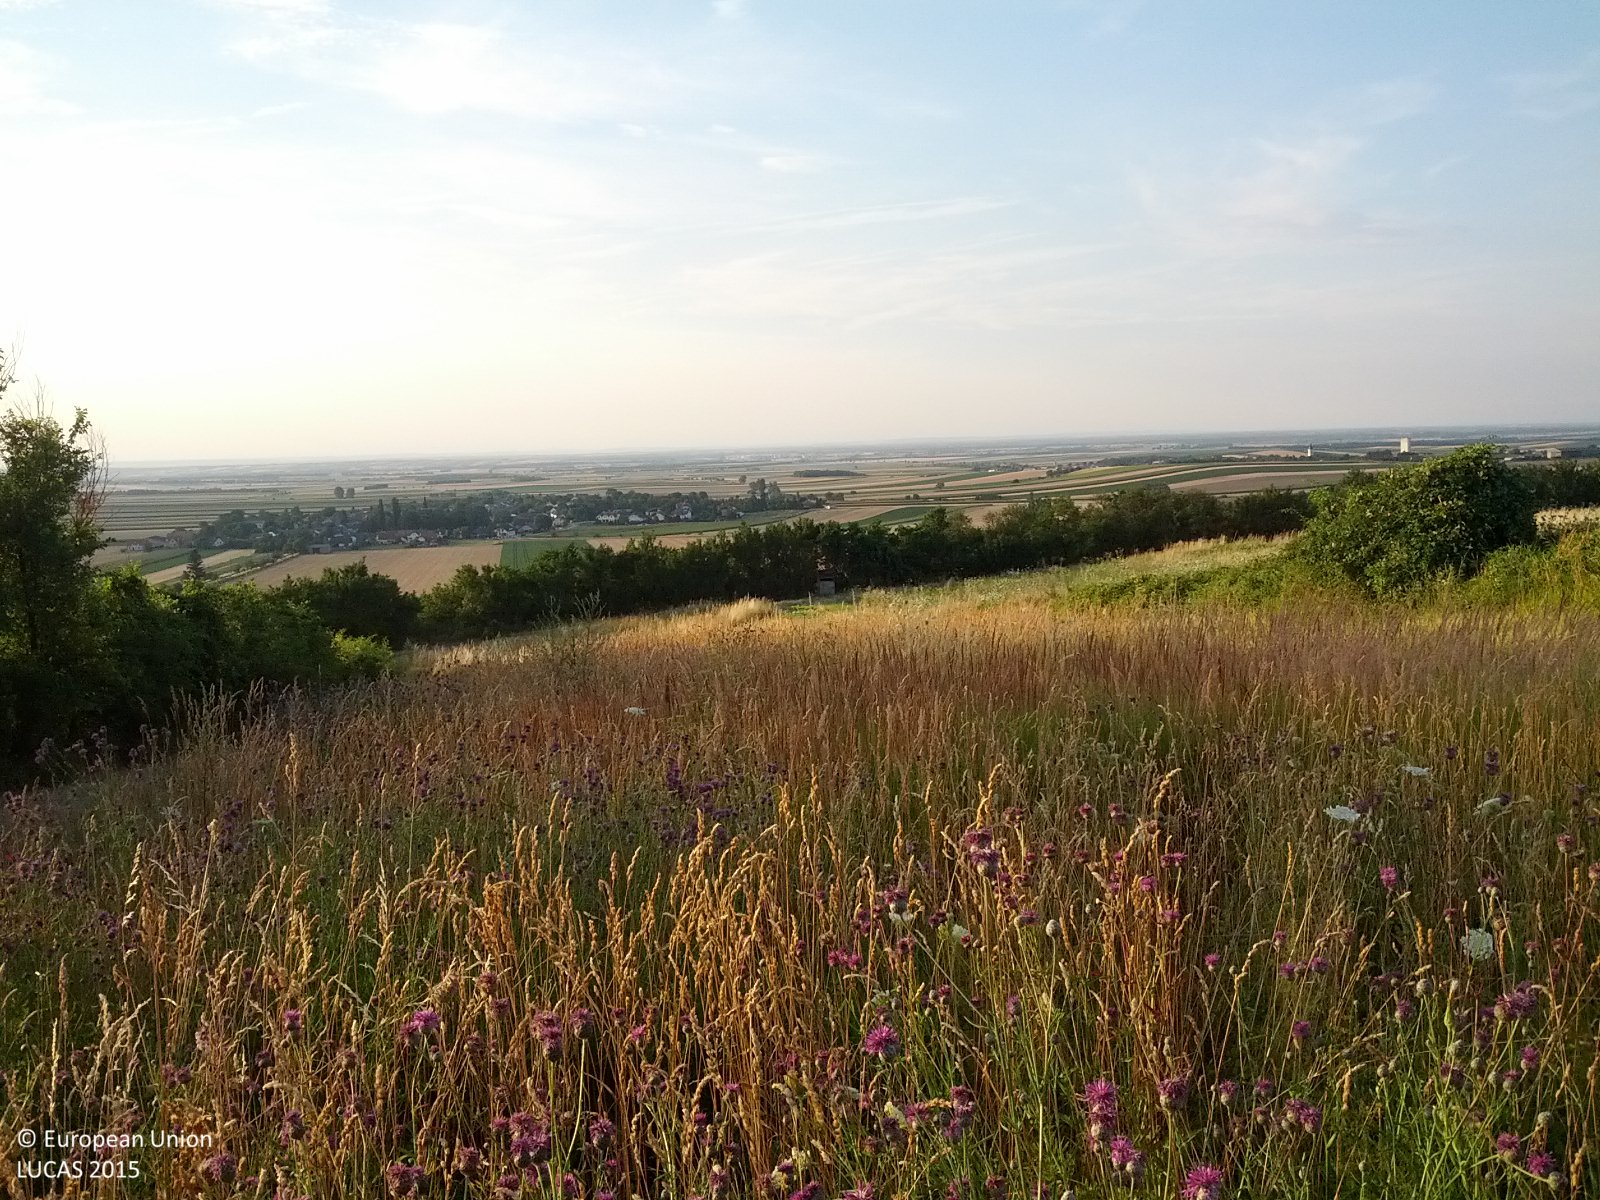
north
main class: Grassland
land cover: Grassland without tree/shrub cover
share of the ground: > 75 %
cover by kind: herbaceous plants 100 %
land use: Agriculture (excluding fallow land and kitchen gardens)
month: July
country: AT
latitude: 48.6216
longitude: 16.2865
